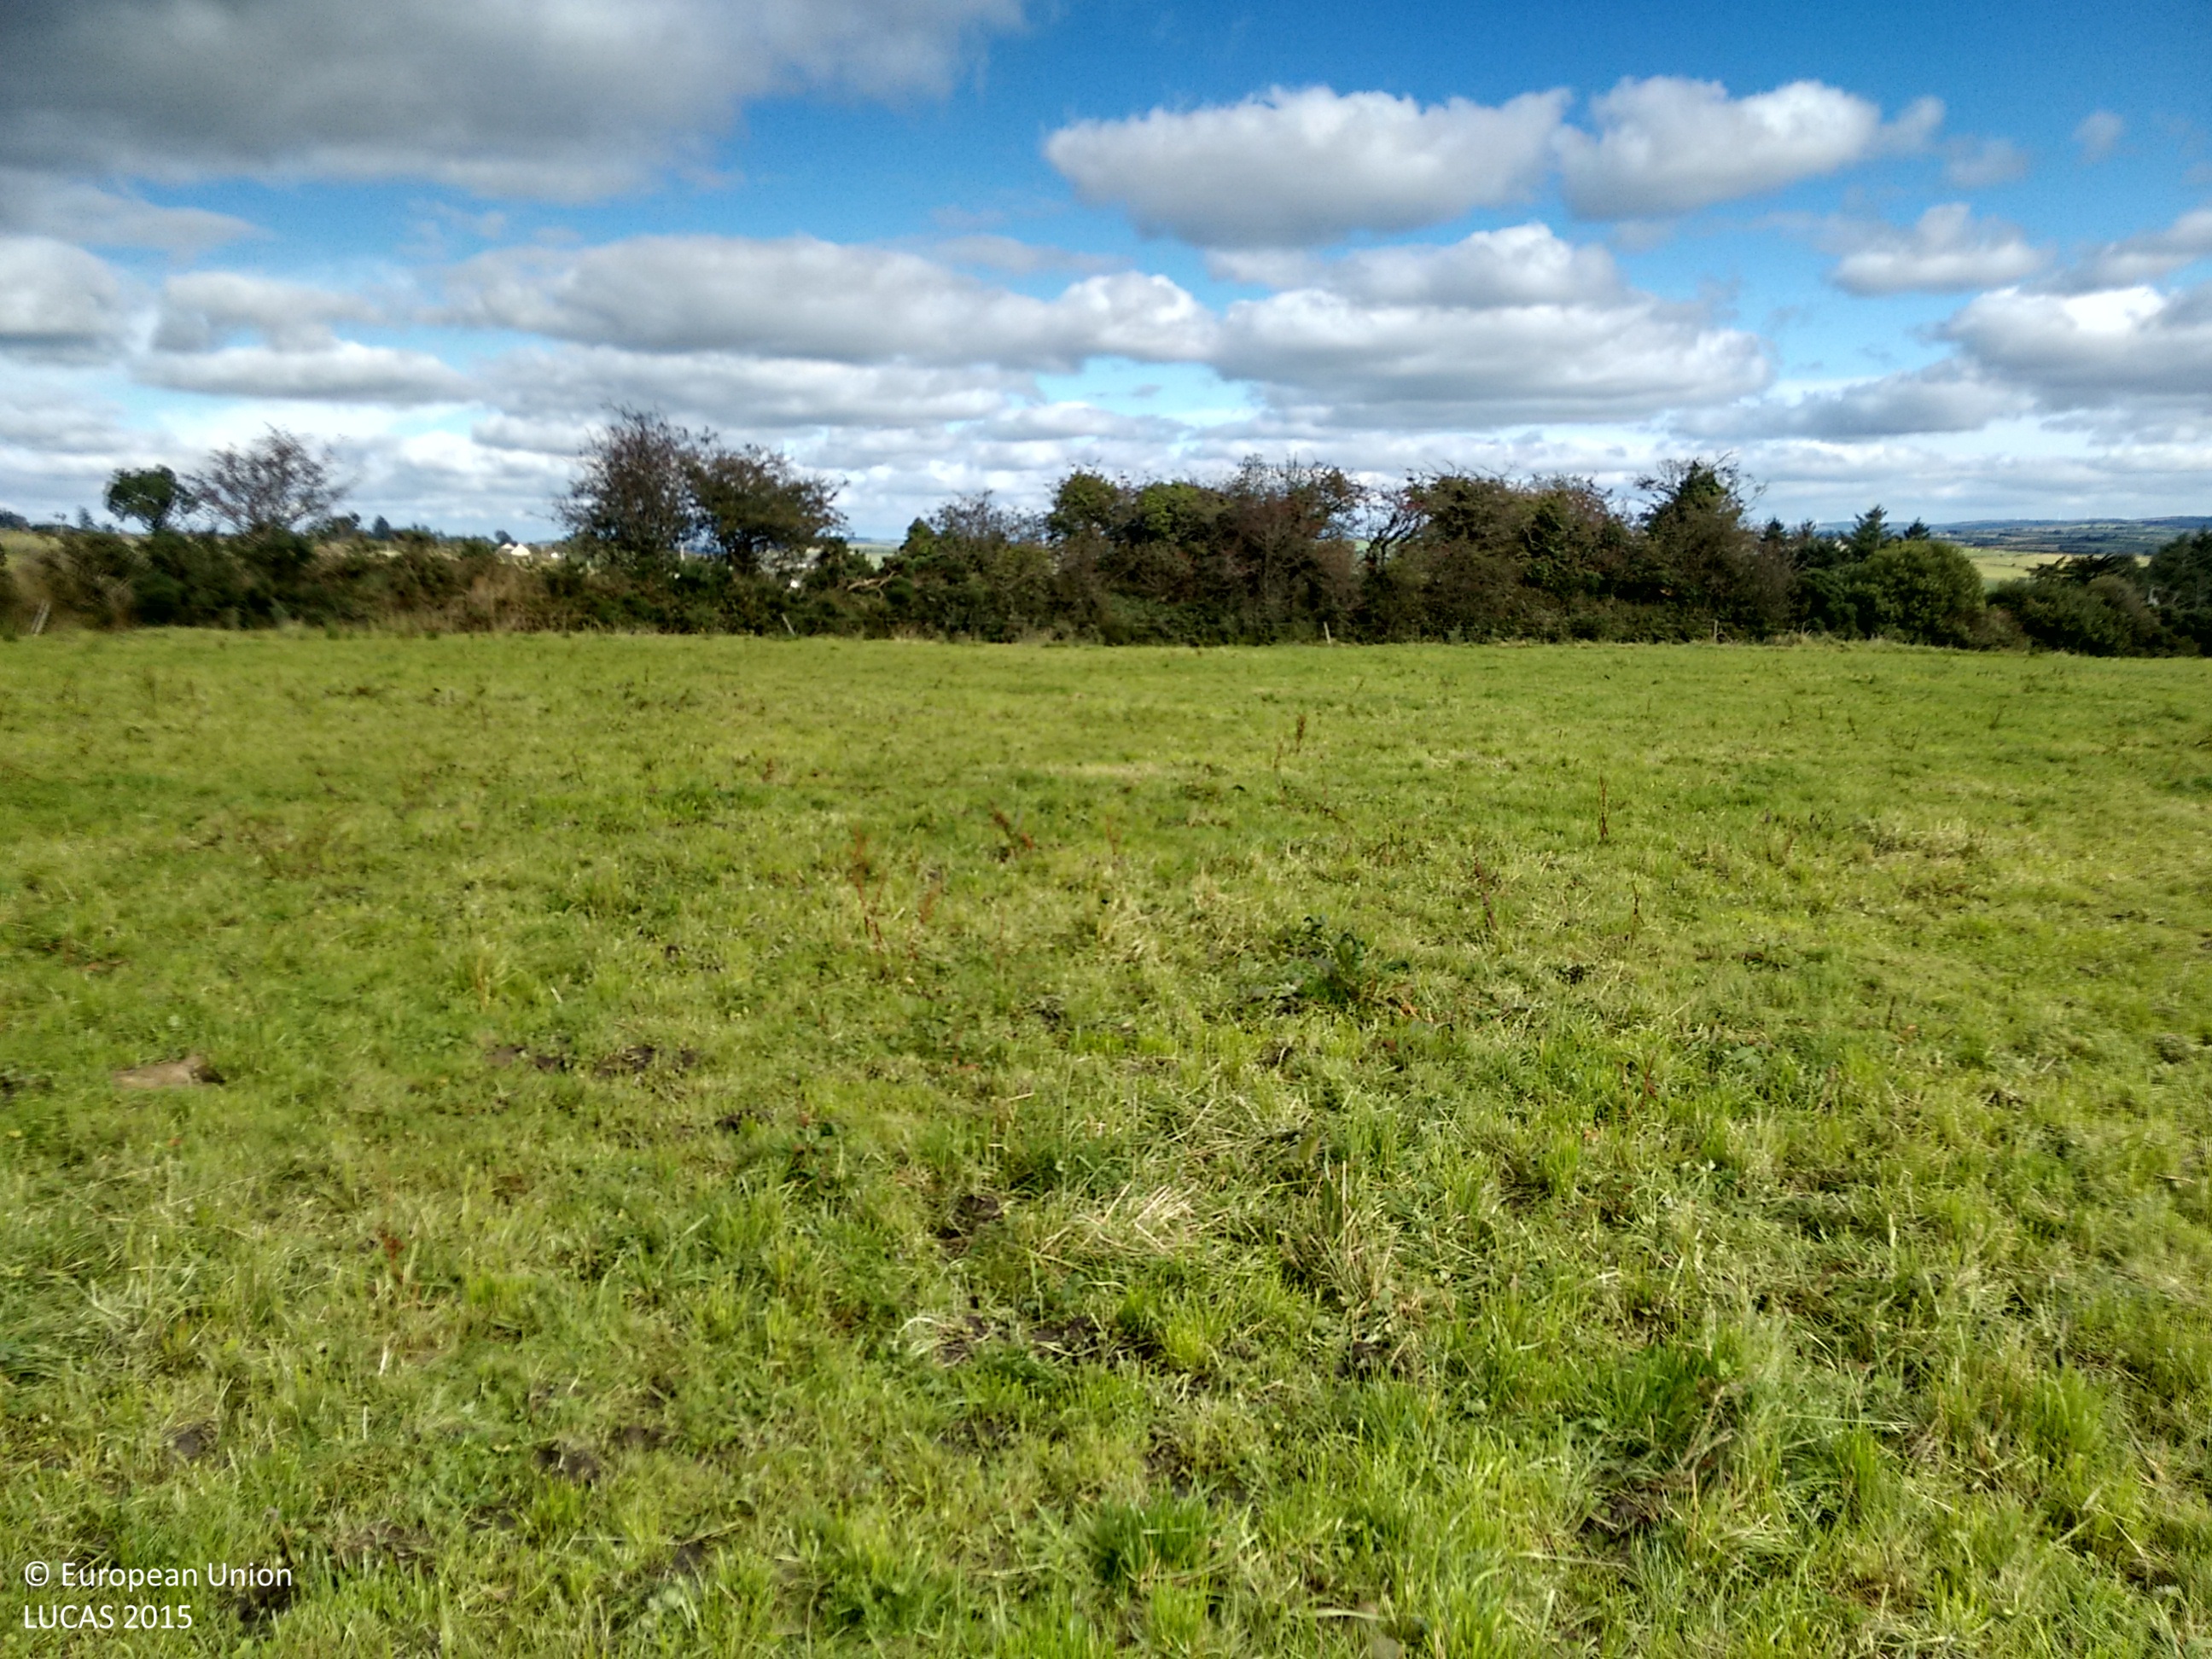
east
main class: Grassland
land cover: Grassland without tree/shrub cover
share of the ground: > 75 %
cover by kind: herbaceous plants 85 %, unconsolidated bare surface 10 %, shrubs 5 %
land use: Agriculture (excluding fallow land and kitchen gardens)
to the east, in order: Grassland without tree/shrub cover; Fences; Ditches and canals; Abandoned hedges; Grassland without tree/shrub cover; Abandoned hedges; Grassland without tree/shrub cover; Abandoned hedges; Artificial constructions in urban areas; Grassland without tree/shrub cover
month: September
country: IE
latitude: 52.3272
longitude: -9.4072
